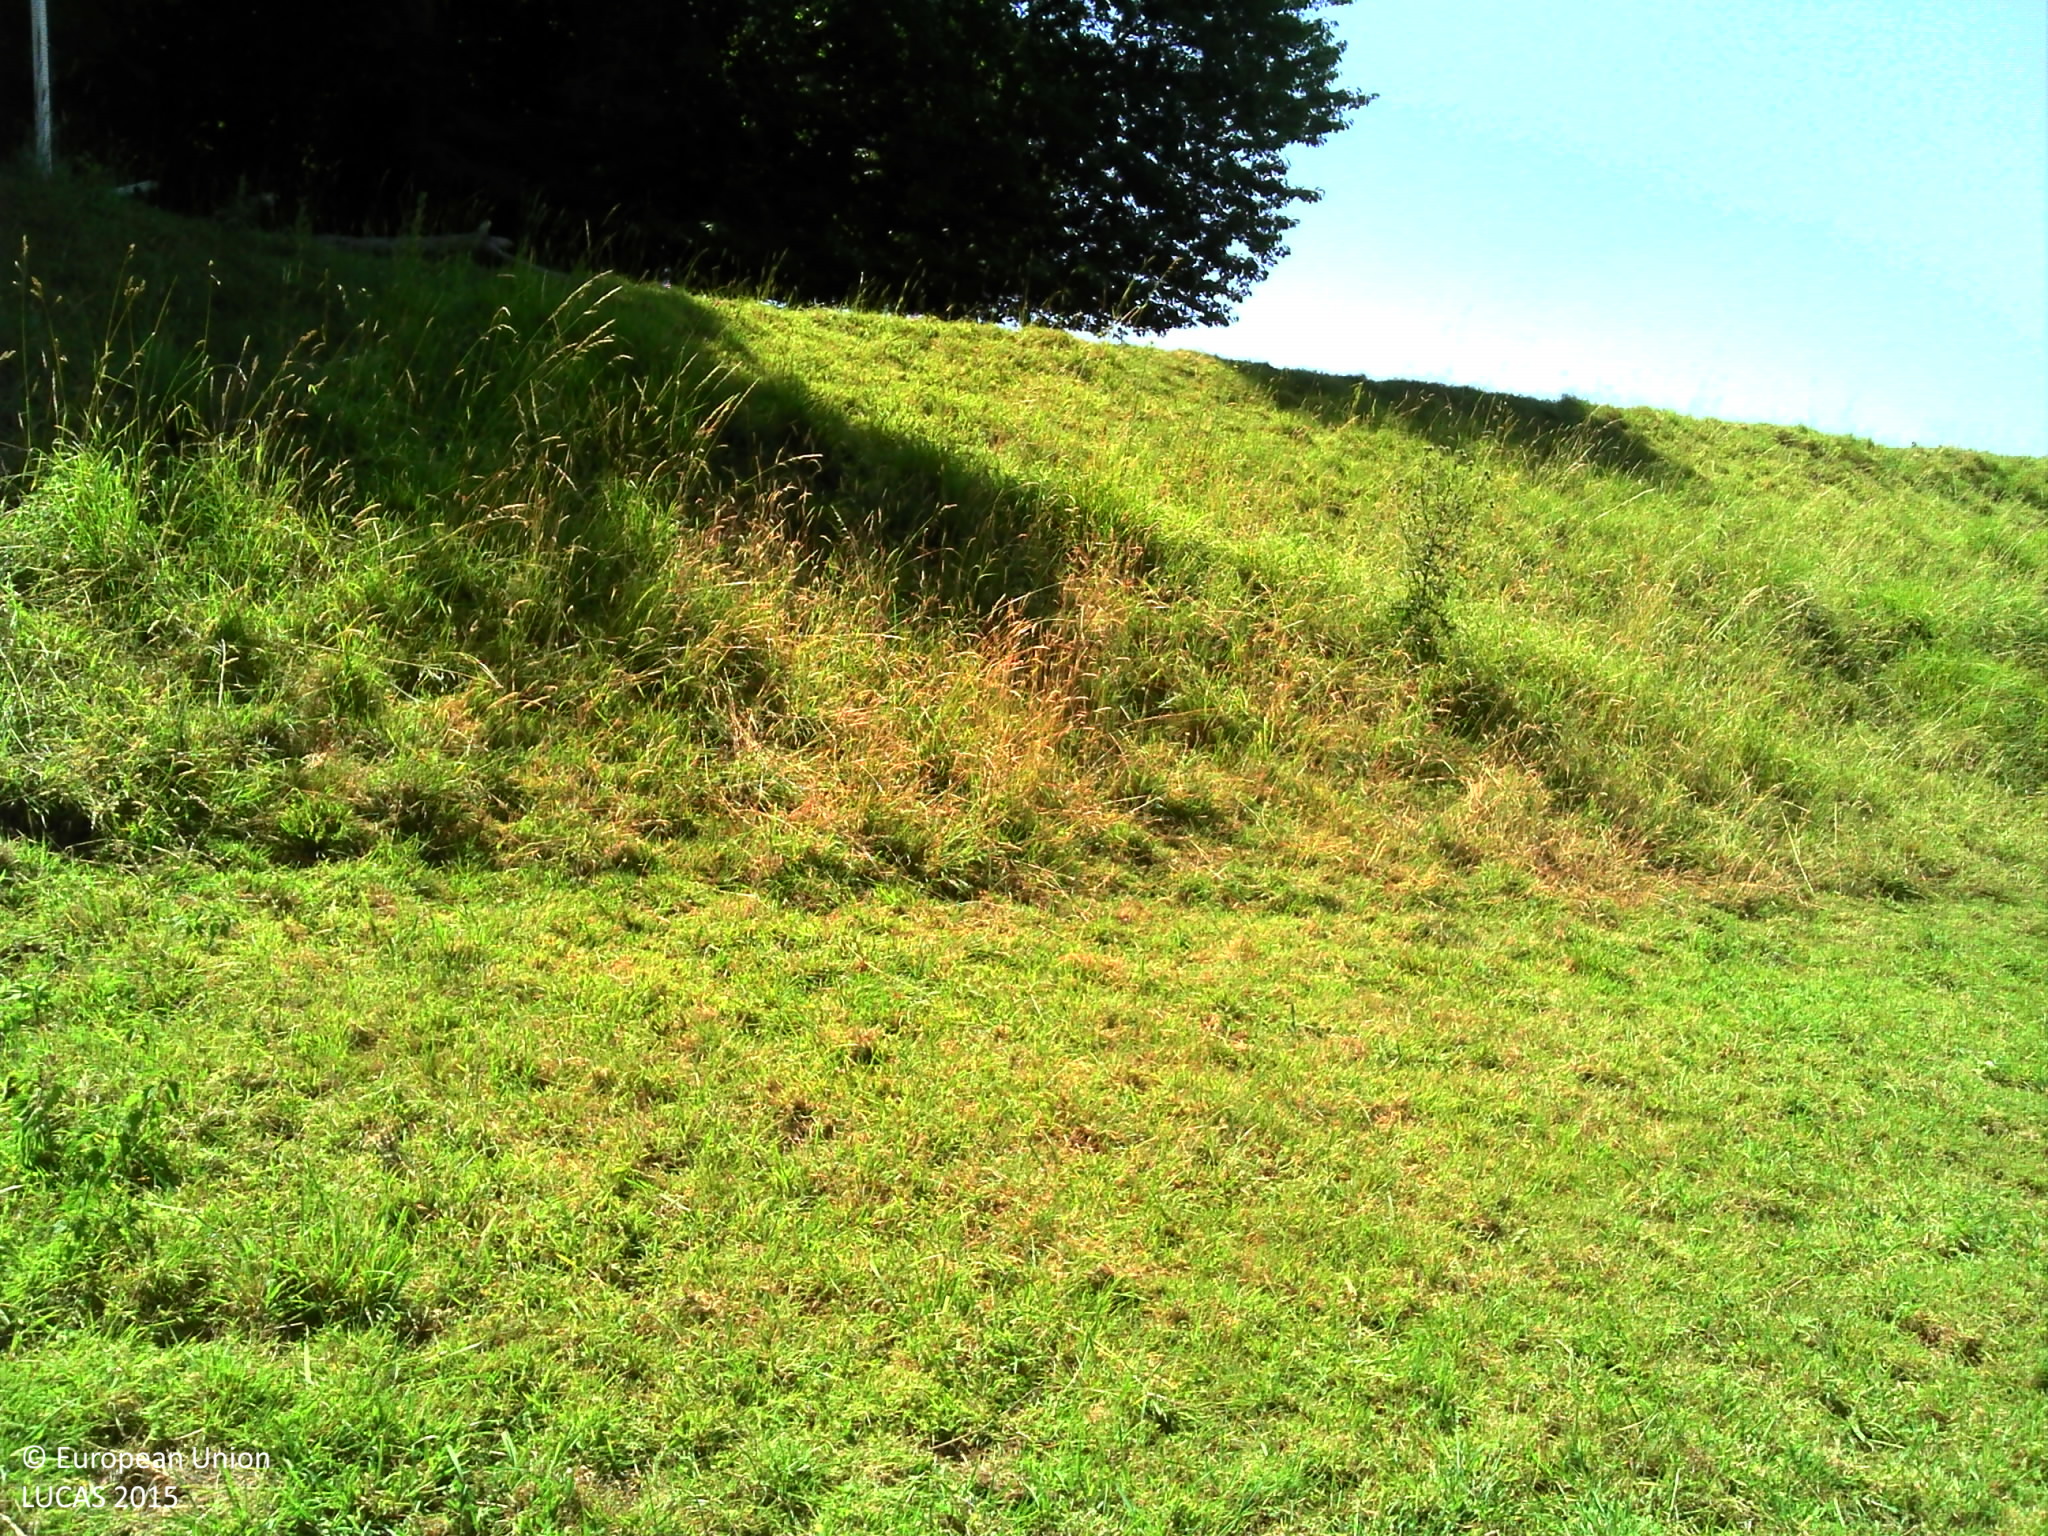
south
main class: Grassland
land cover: Grassland without tree/shrub cover
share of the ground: > 75 %
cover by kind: herbaceous plants 95 %
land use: Agriculture (excluding fallow land and kitchen gardens)
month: July
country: FR
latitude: 50.3258
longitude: 2.1049
